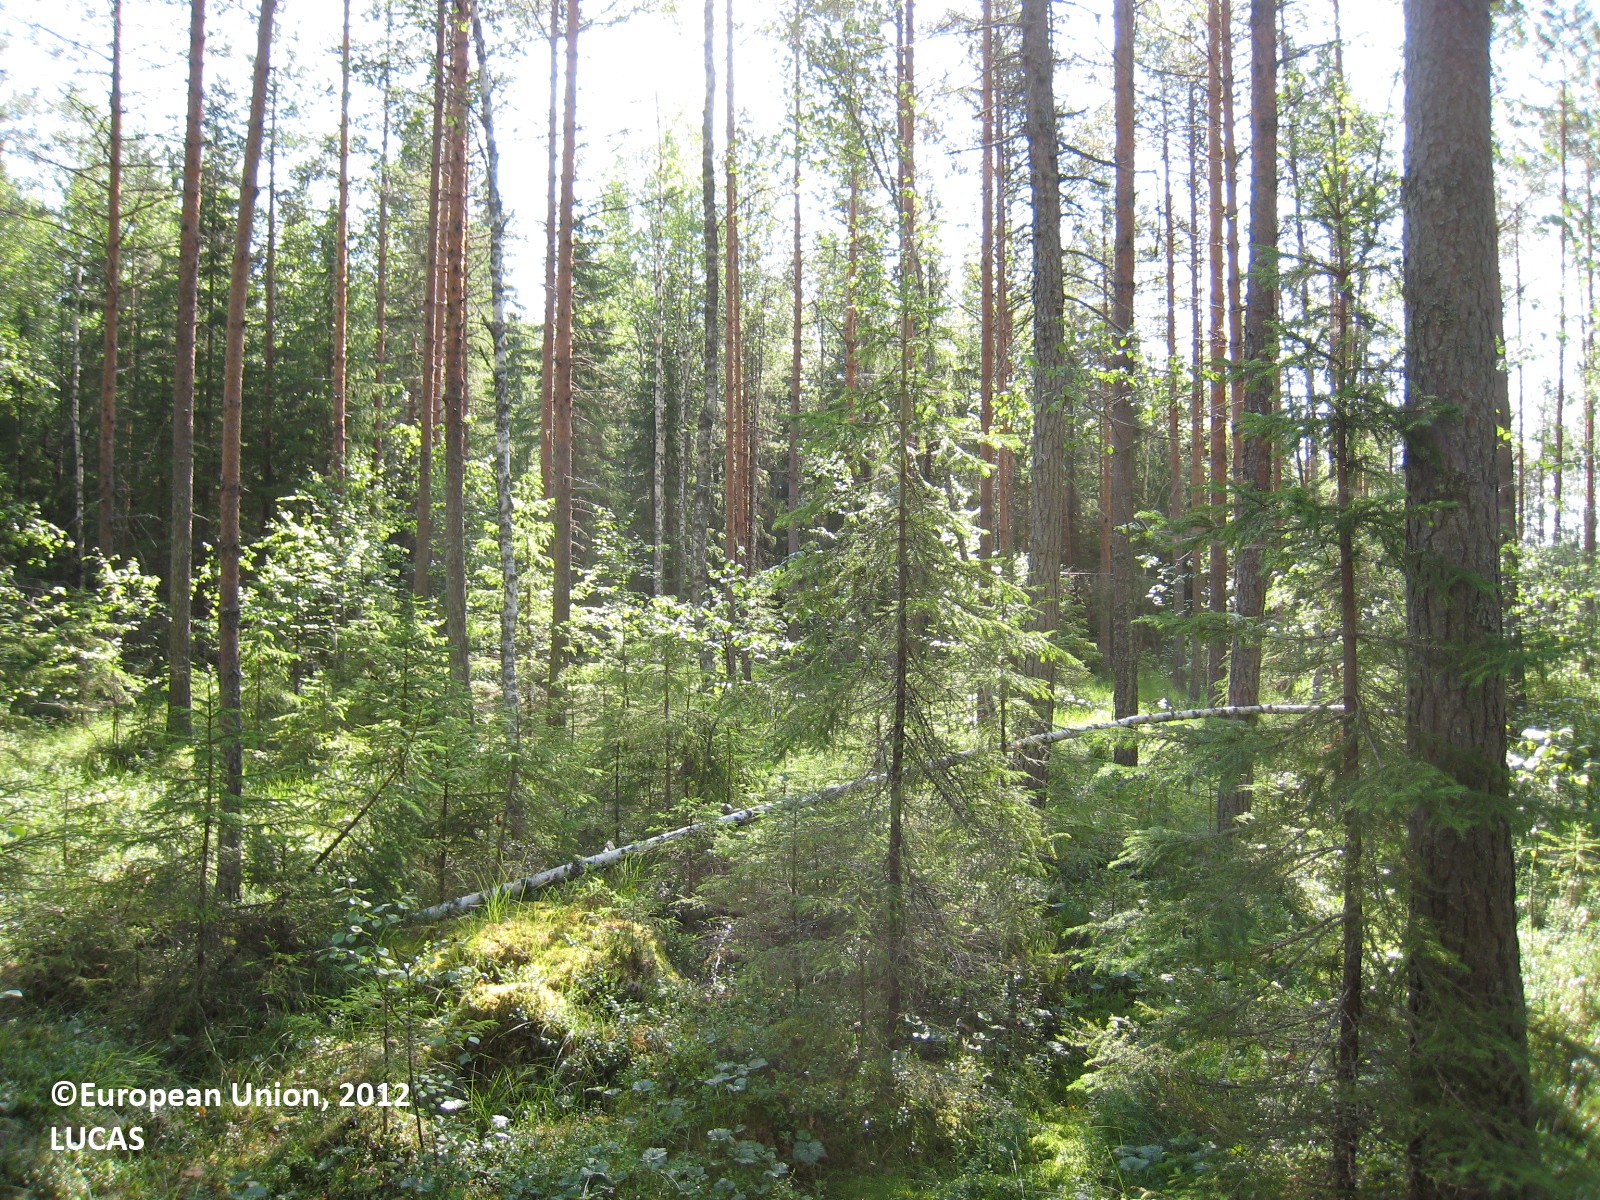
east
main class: Woodland
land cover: Pine dominated mixed woodland
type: mire and swamp forests
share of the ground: 50 - 75 %
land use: Forestry
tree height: > 5 m
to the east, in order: Pine dominated mixed woodland; Ditches and canals; Pine dominated mixed woodland; Ditches and canals; Other mixed woodland; Ditches and canals; Spruce dominated mixed woodland; Ditches and canals; Spruce dominated mixed woodland; Other mixed woodland; Ditches and canals; Other mixed woodland; Ditches and canals; Other mixed woodland; Pine dominated mixed woodland; Ditches and canals; Pine dominated mixed woodland
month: July
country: FI
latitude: 61.7895
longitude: 27.0961
